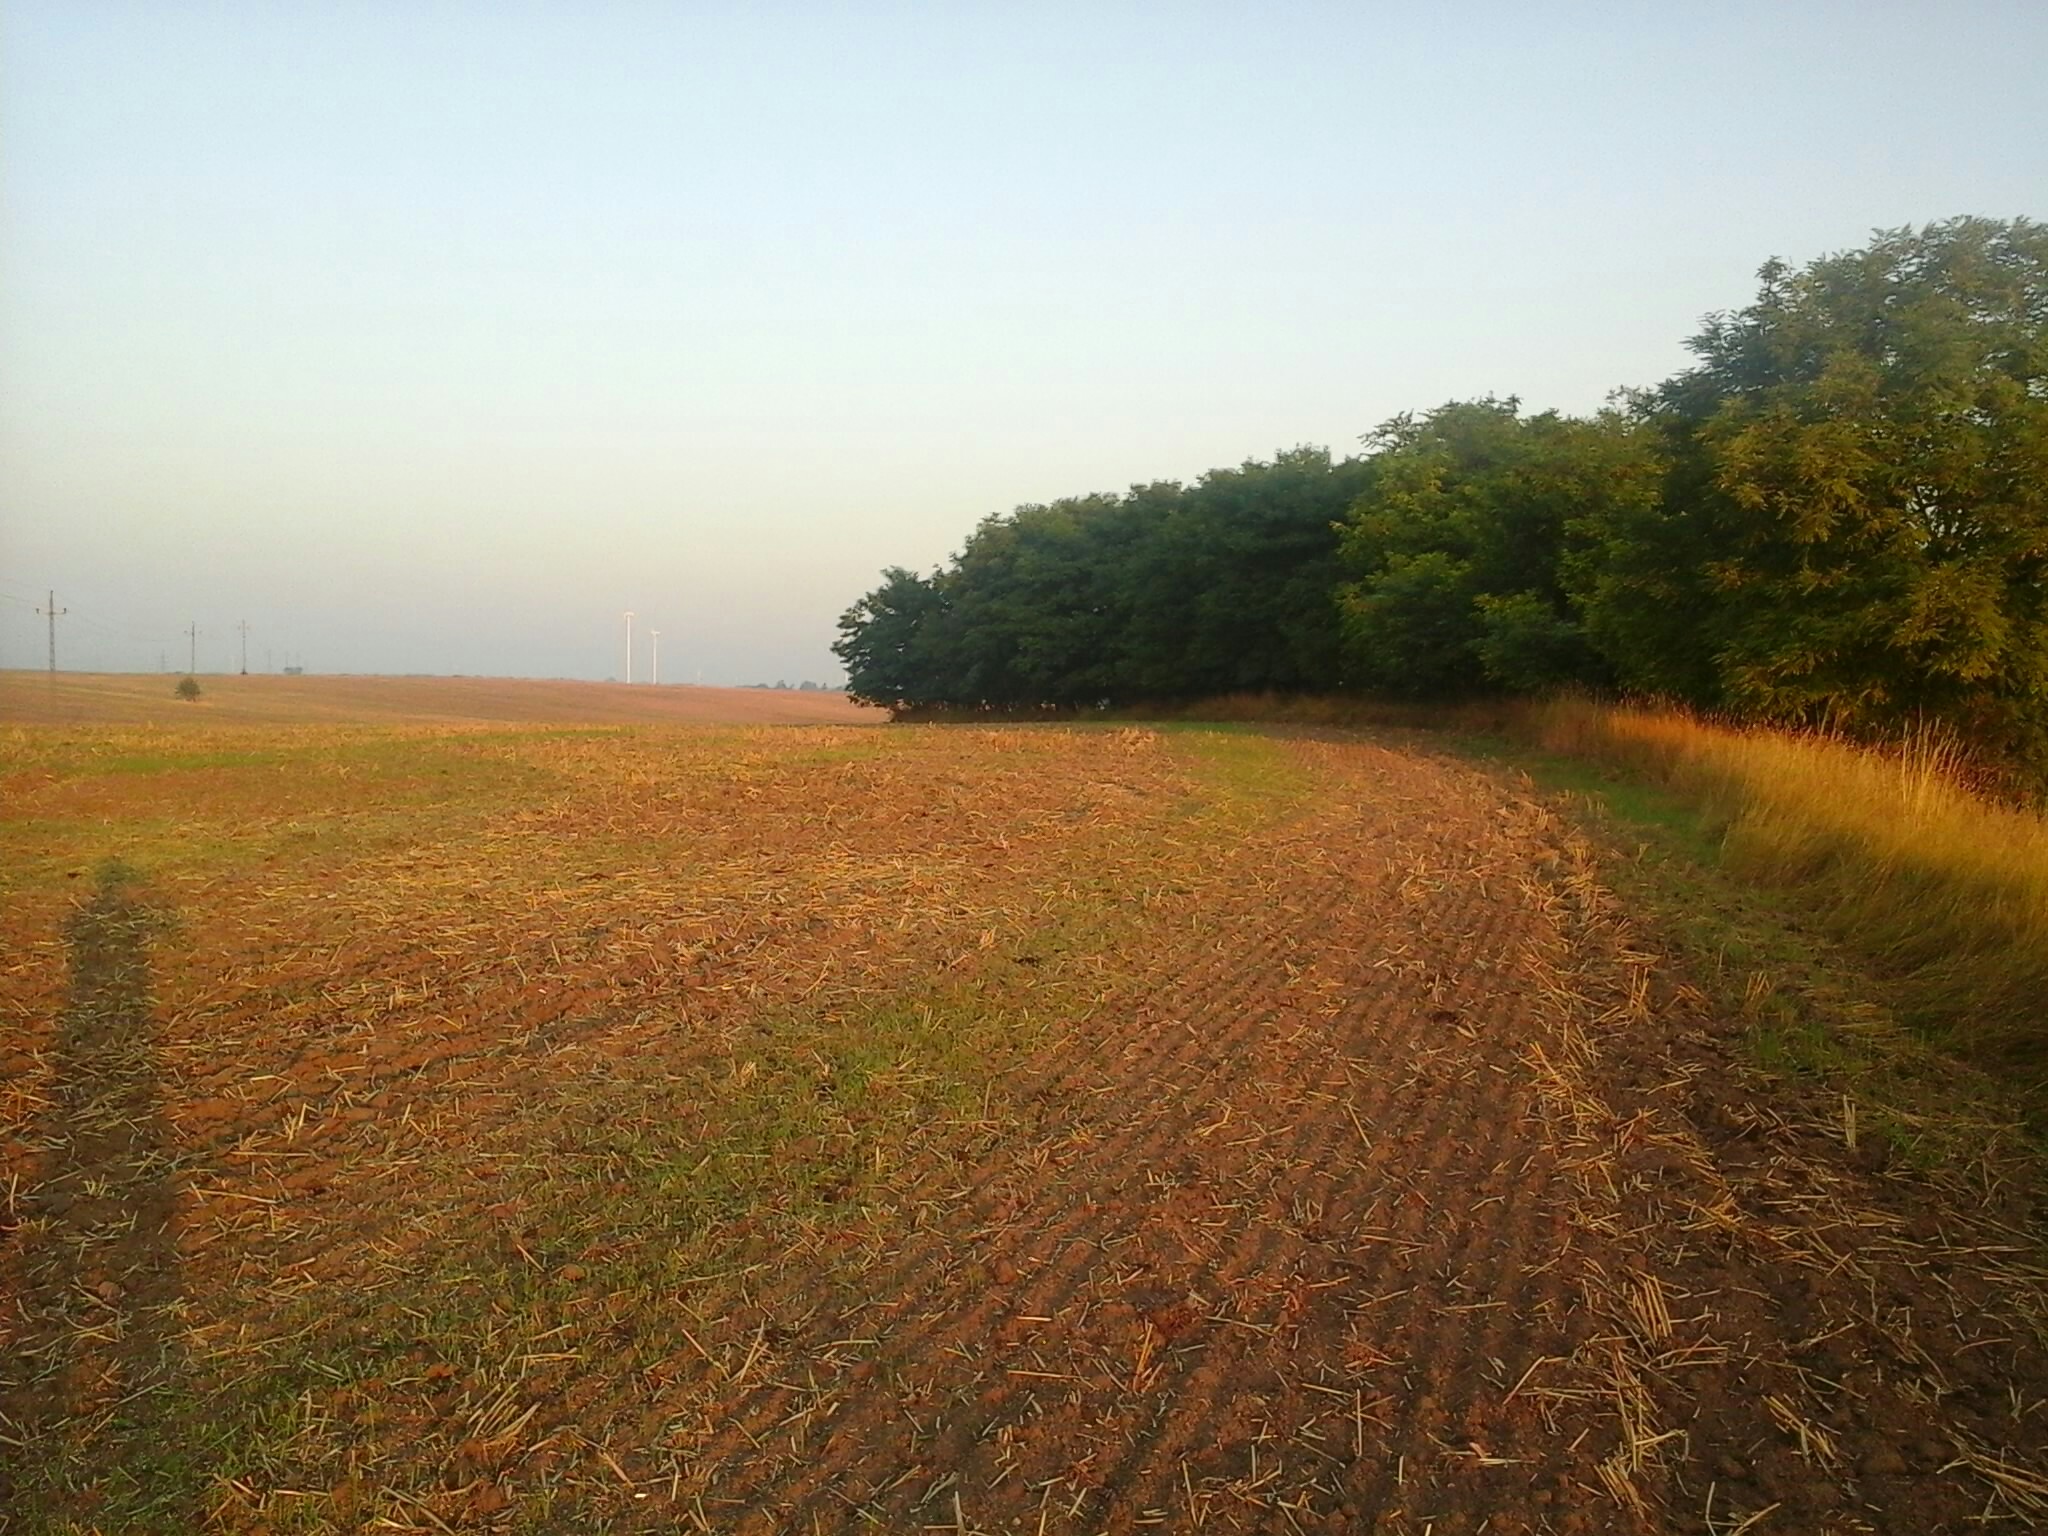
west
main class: Cropland
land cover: Common wheat
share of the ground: < 10 %
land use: Agriculture (excluding fallow land and kitchen gardens)
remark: Harvested field
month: August
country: HU
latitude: 47.6703
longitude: 18.1228
